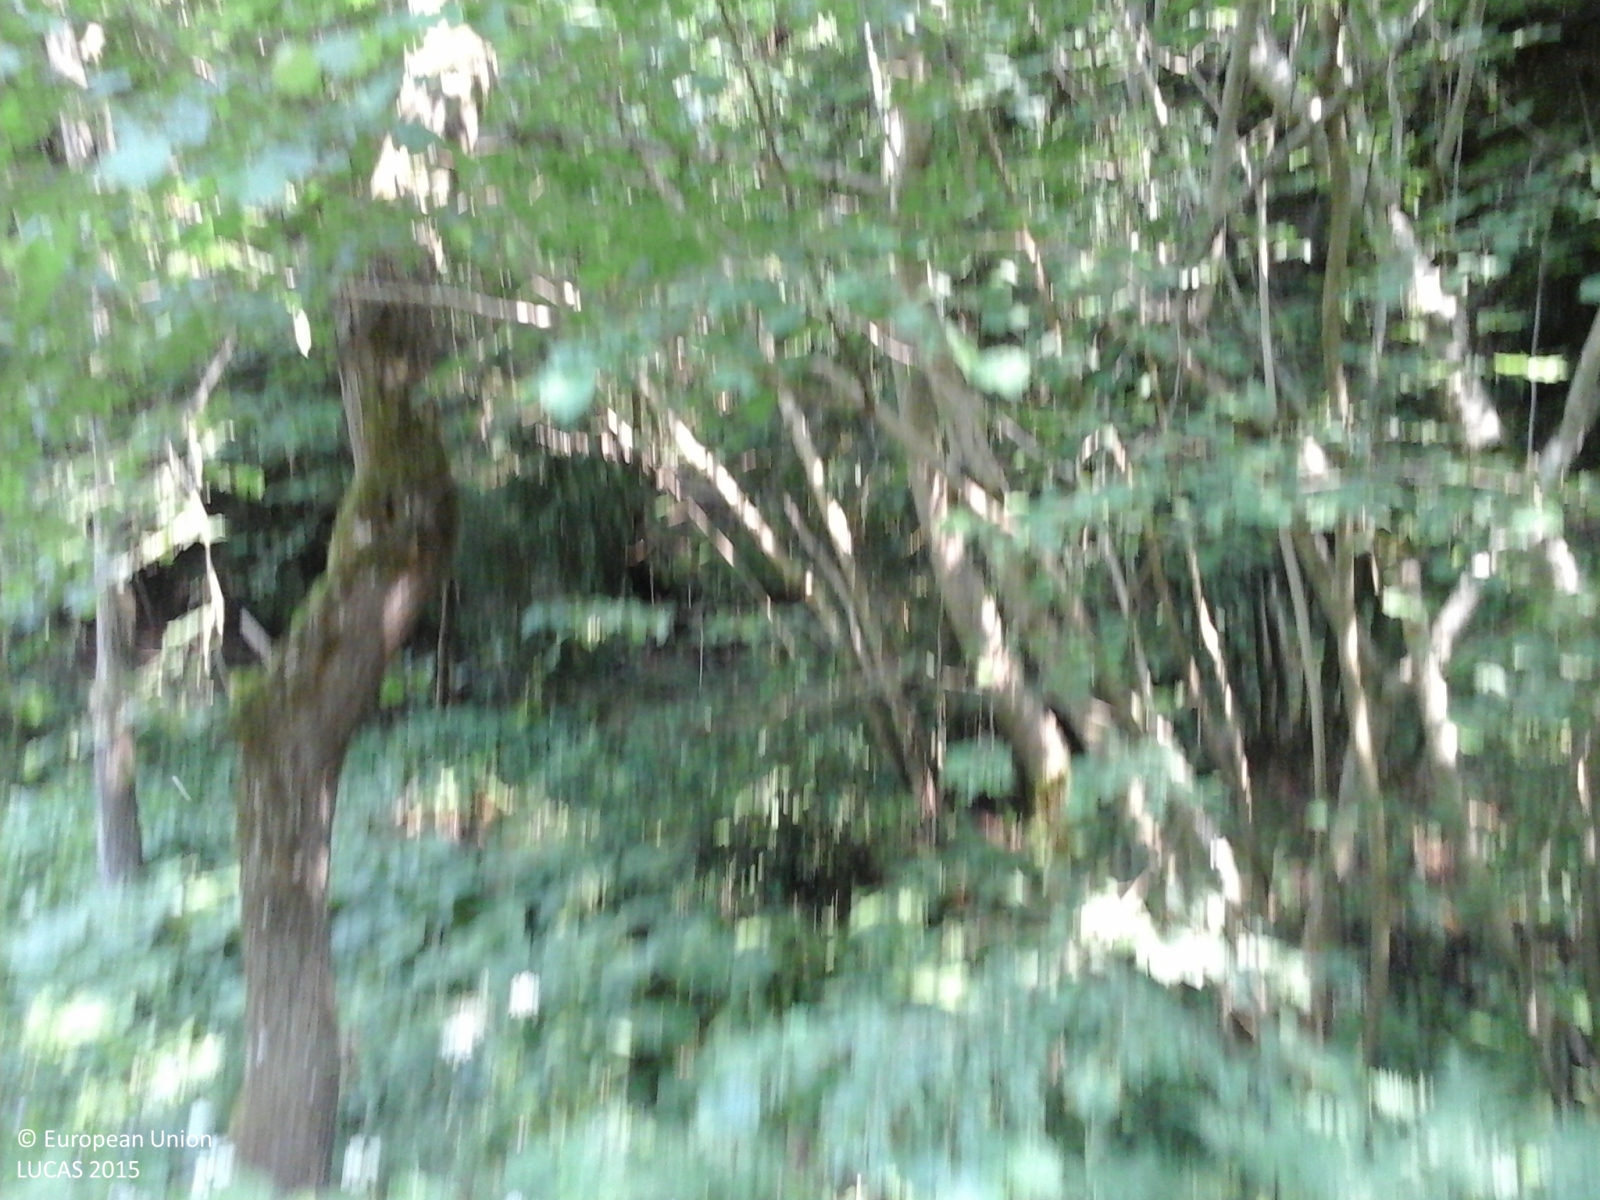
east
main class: Woodland
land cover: Broadleaved woodland
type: mountainous beech forest
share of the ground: > 75 %
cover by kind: broadleaved forest trees 100 %
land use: Forestry
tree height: > 5 m
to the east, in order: Broadleaved woodland; Rivers and streams; Electric lines; Broadleaved woodland; Paved roads, cycling and walking lanes; Grass margins; Rivers and streams; Broadleaved woodland
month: July
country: IT
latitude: 44.4045
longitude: 7.2557
